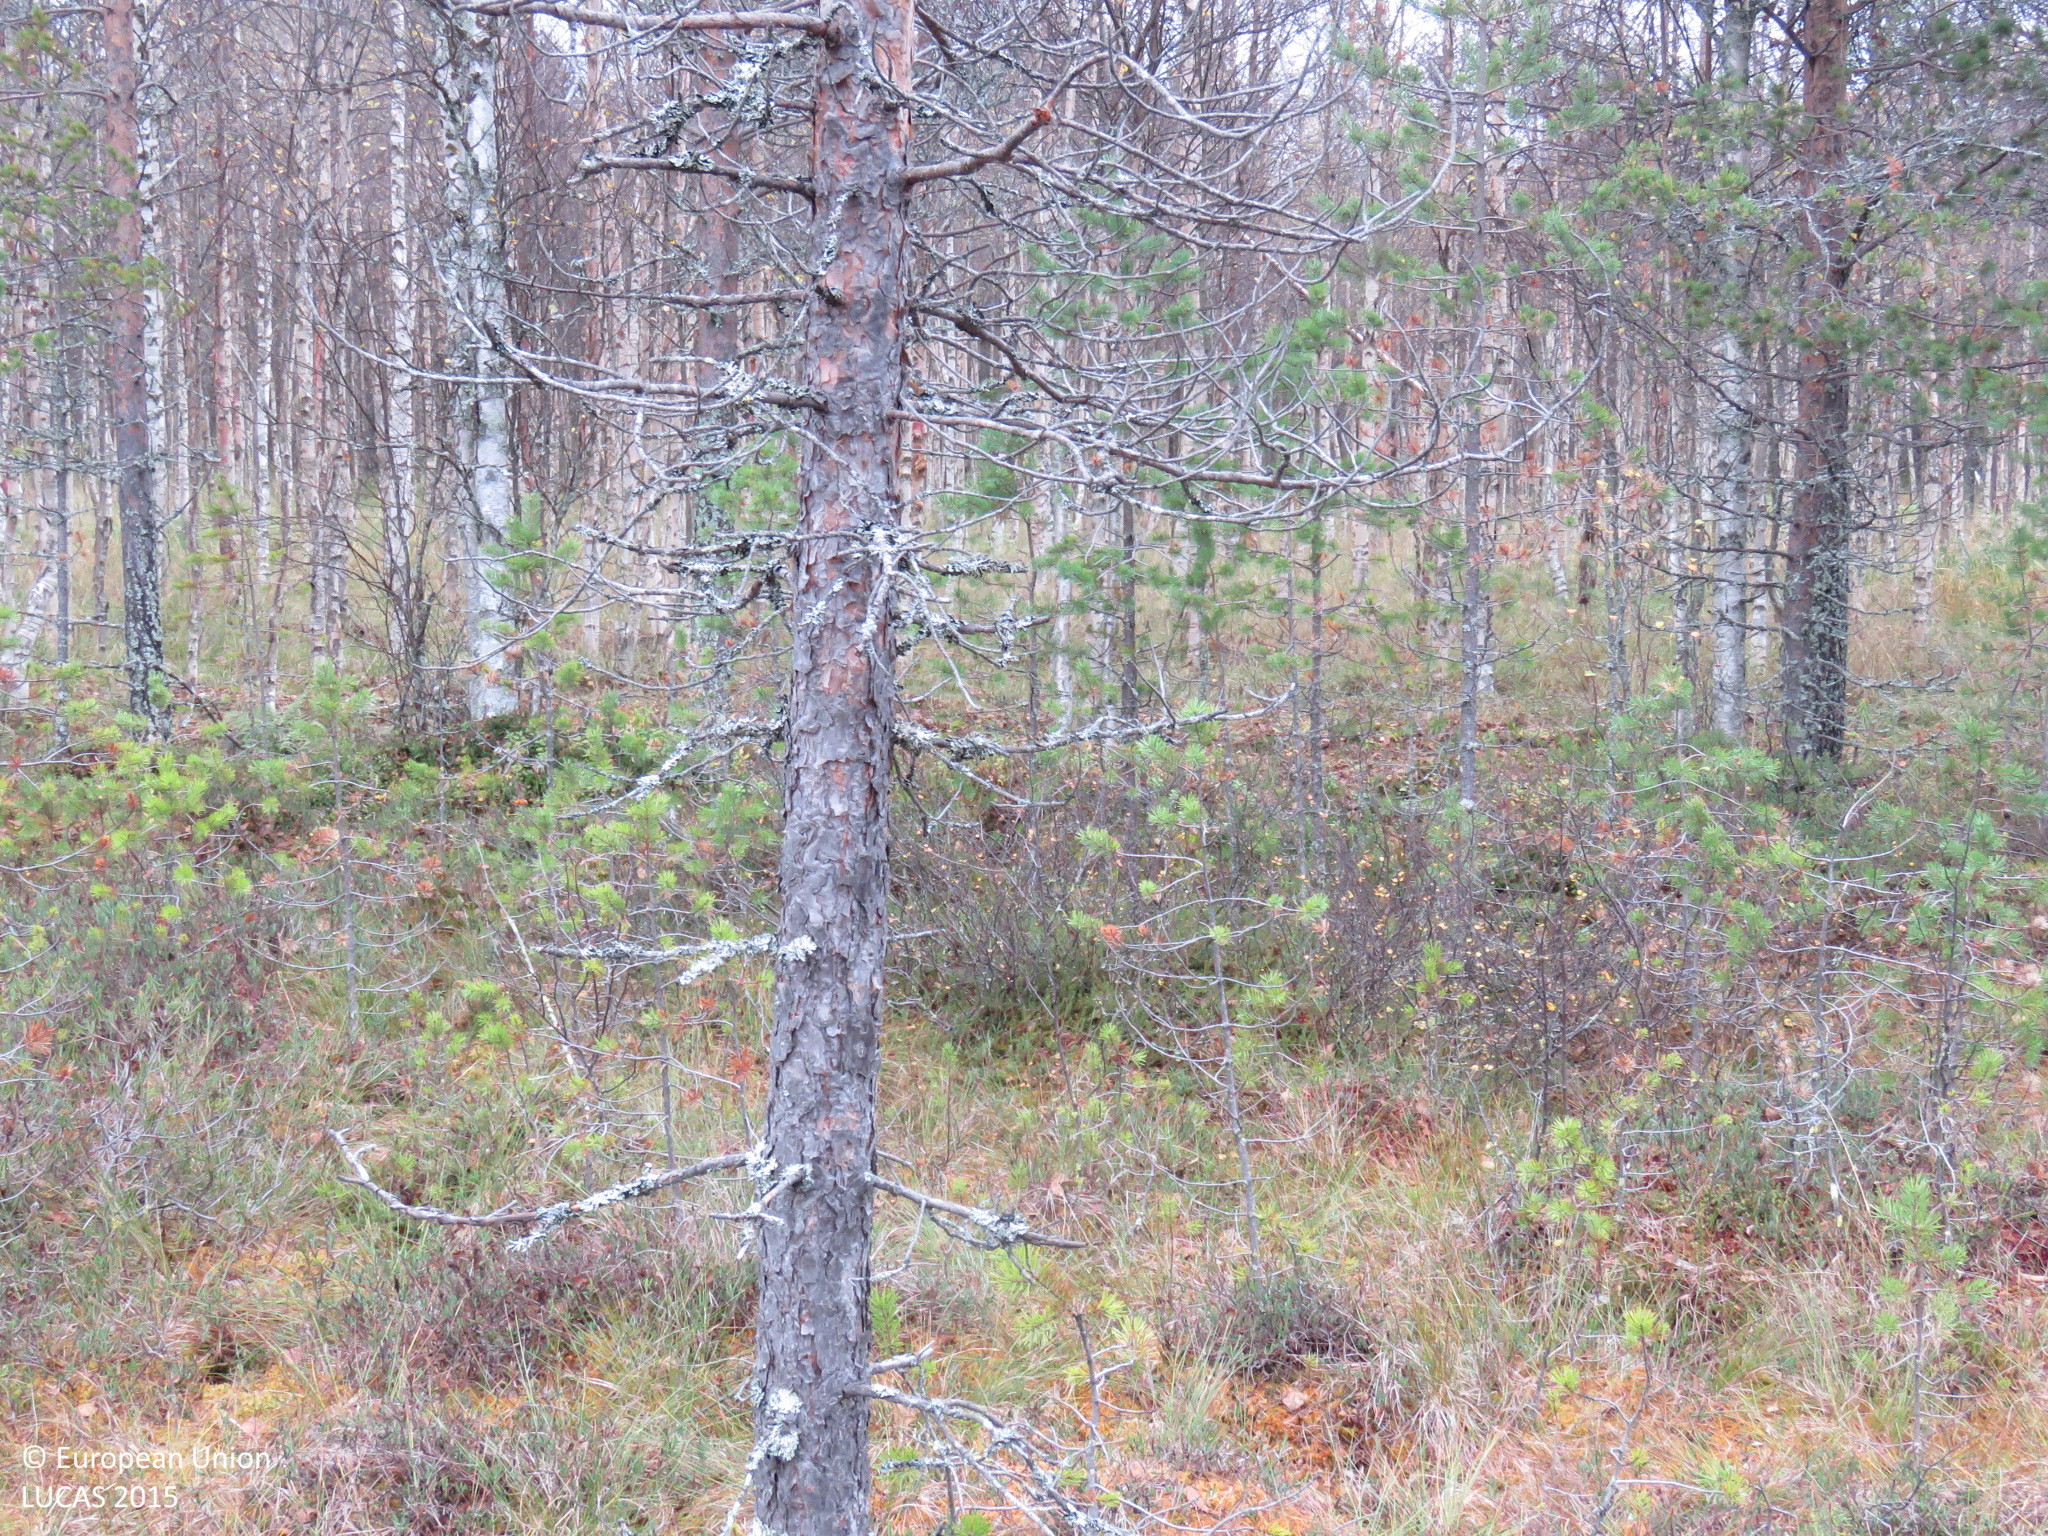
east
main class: Woodland
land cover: Pine dominated coniferous woodland
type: mire and swamp forests
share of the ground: 25 - 50 %
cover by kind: coniferous forest trees 45 %, shrubs 25 %, herbaceous plants 20 %, lichens and mosses 10 %
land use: Forestry
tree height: < 5 m
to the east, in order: Pine dominated coniferous woodland; Ditches and canals; Broadleaved woodland; Ditches and canals; Broadleaved woodland; Ditches and canals; Broadleaved woodland; Ditches and canals; Broadleaved woodland; Ditches and canals; Broadleaved woodland; Ditches and canals; Broadleaved woodland; Ditches and canals; Tracks; Broadleaved woodland; Ditches and canals; Abandoned hedges; Tracks; Pine dominated mixed woodland; Ditches and canals; Temporary grasslands; Grass margins; Ditches and canals; Grass margins; Temporary grasslands; Grass margins; Ditches and canals; Pine dominated mixed woodland
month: September
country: FI
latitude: 65.2751
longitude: 26.8043
